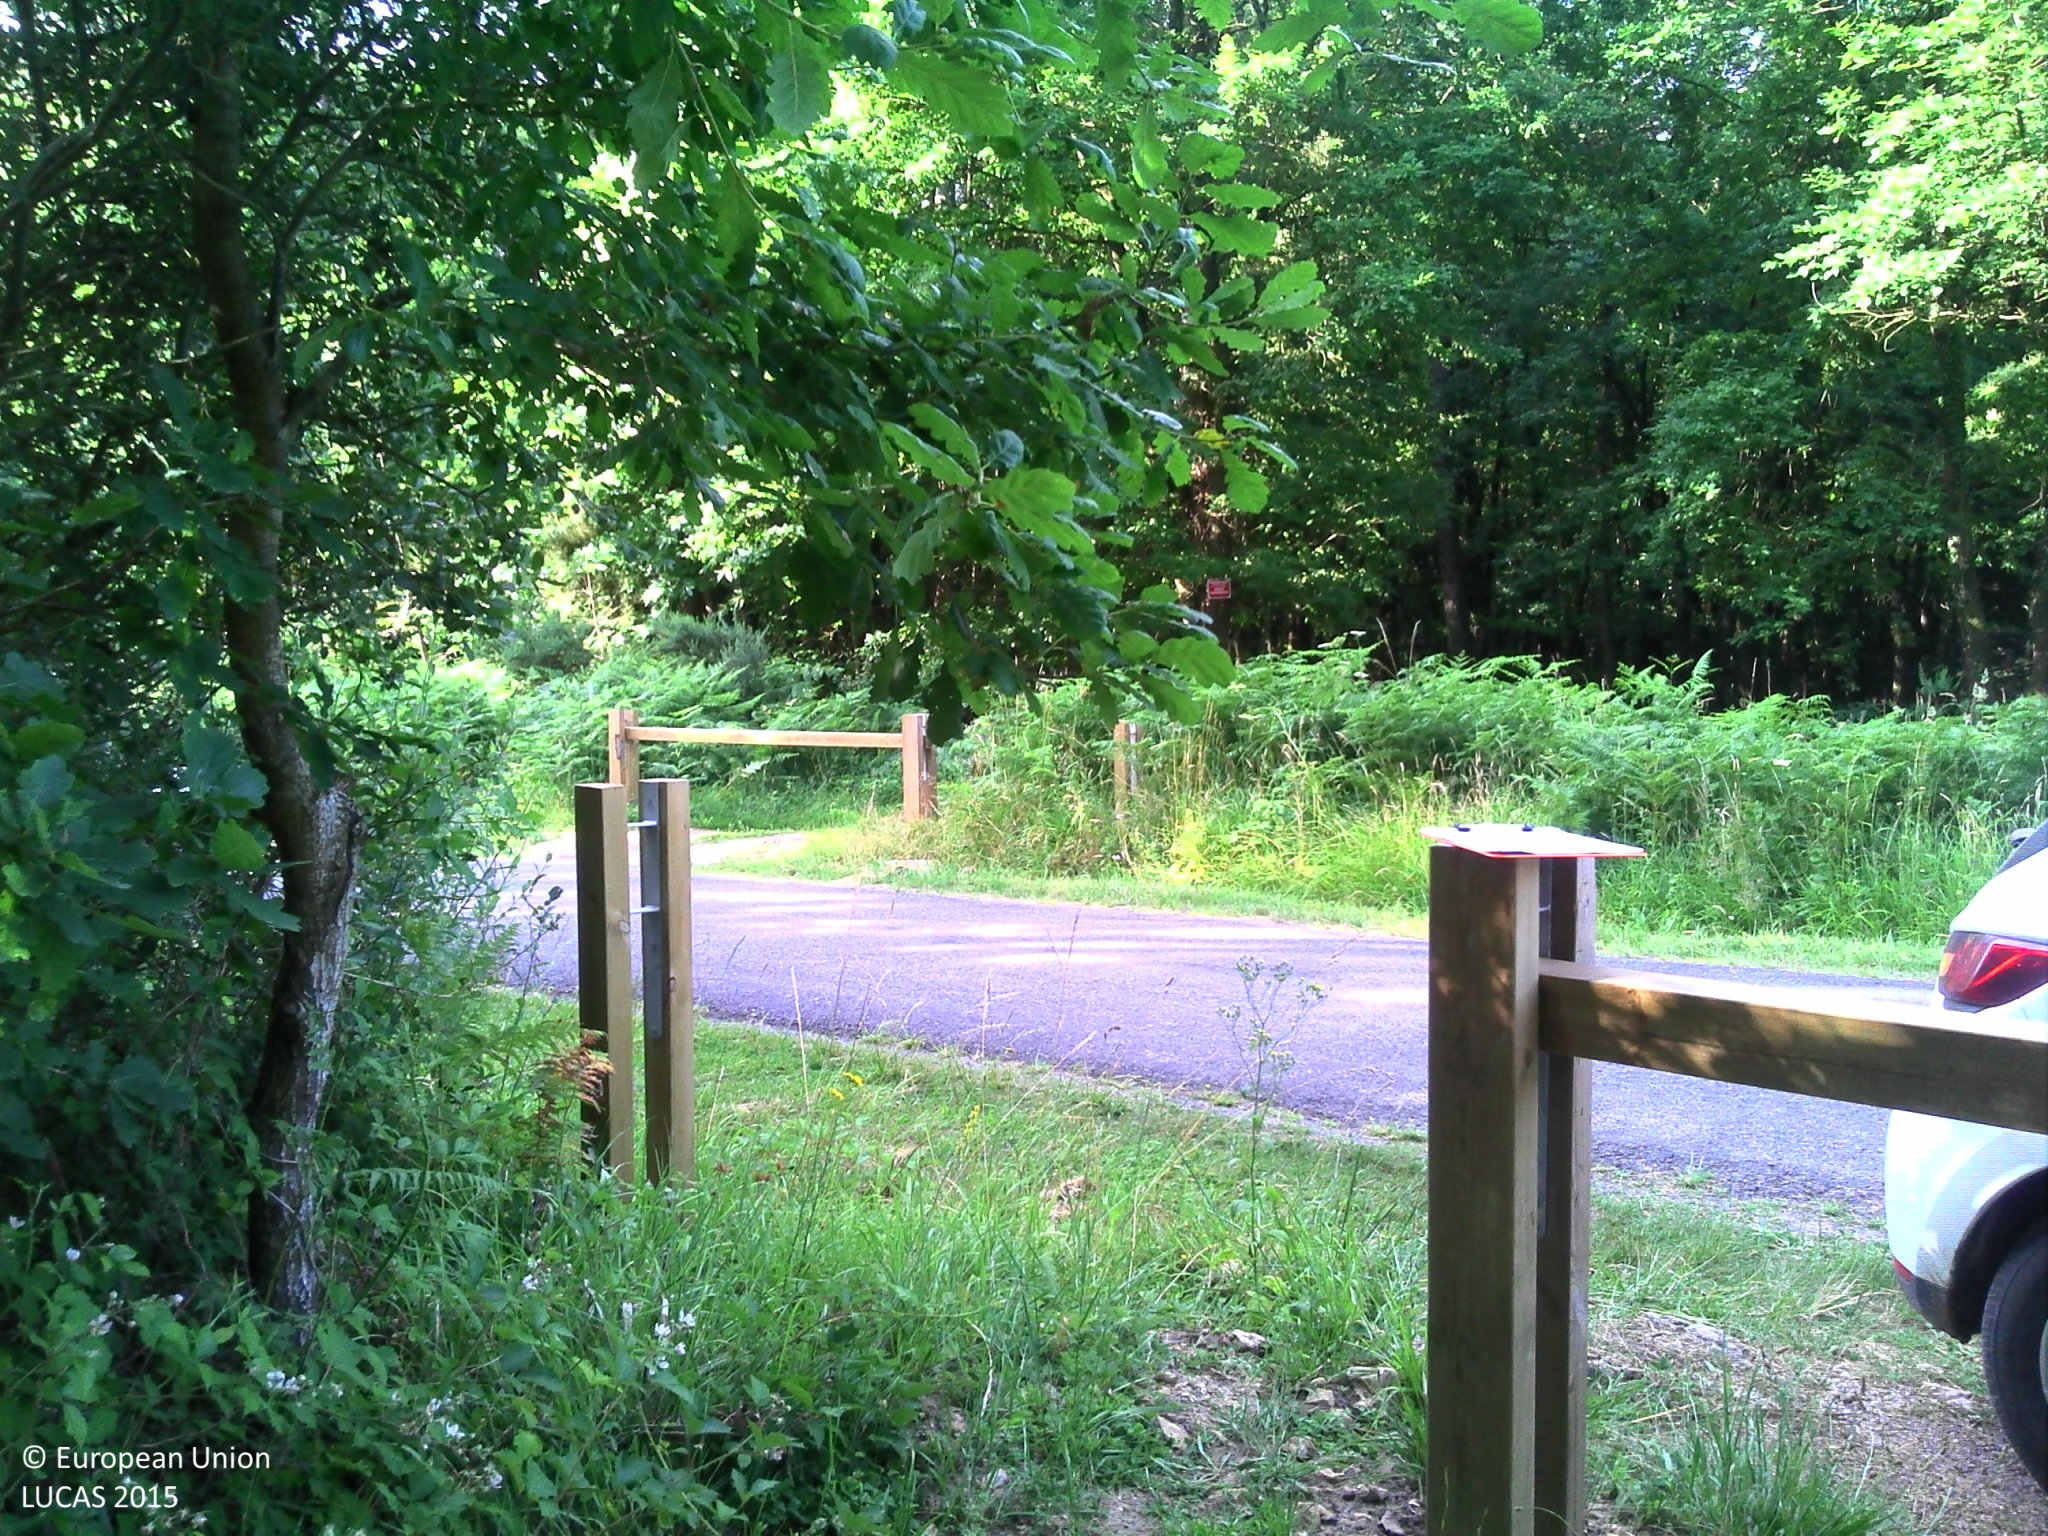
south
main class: Woodland
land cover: Pine dominated mixed woodland
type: hemiboreal forest and nemoral coniferous forest and mixed broadleaved-coniferous forest
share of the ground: > 75 %
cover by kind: broadleaved forest trees 55 %, coniferous forest trees 25 %, shrubs 10 %, herbaceous plants 10 %
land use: Forestry
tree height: > 5 m
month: June
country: FR
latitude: 46.5231
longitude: 0.2689
